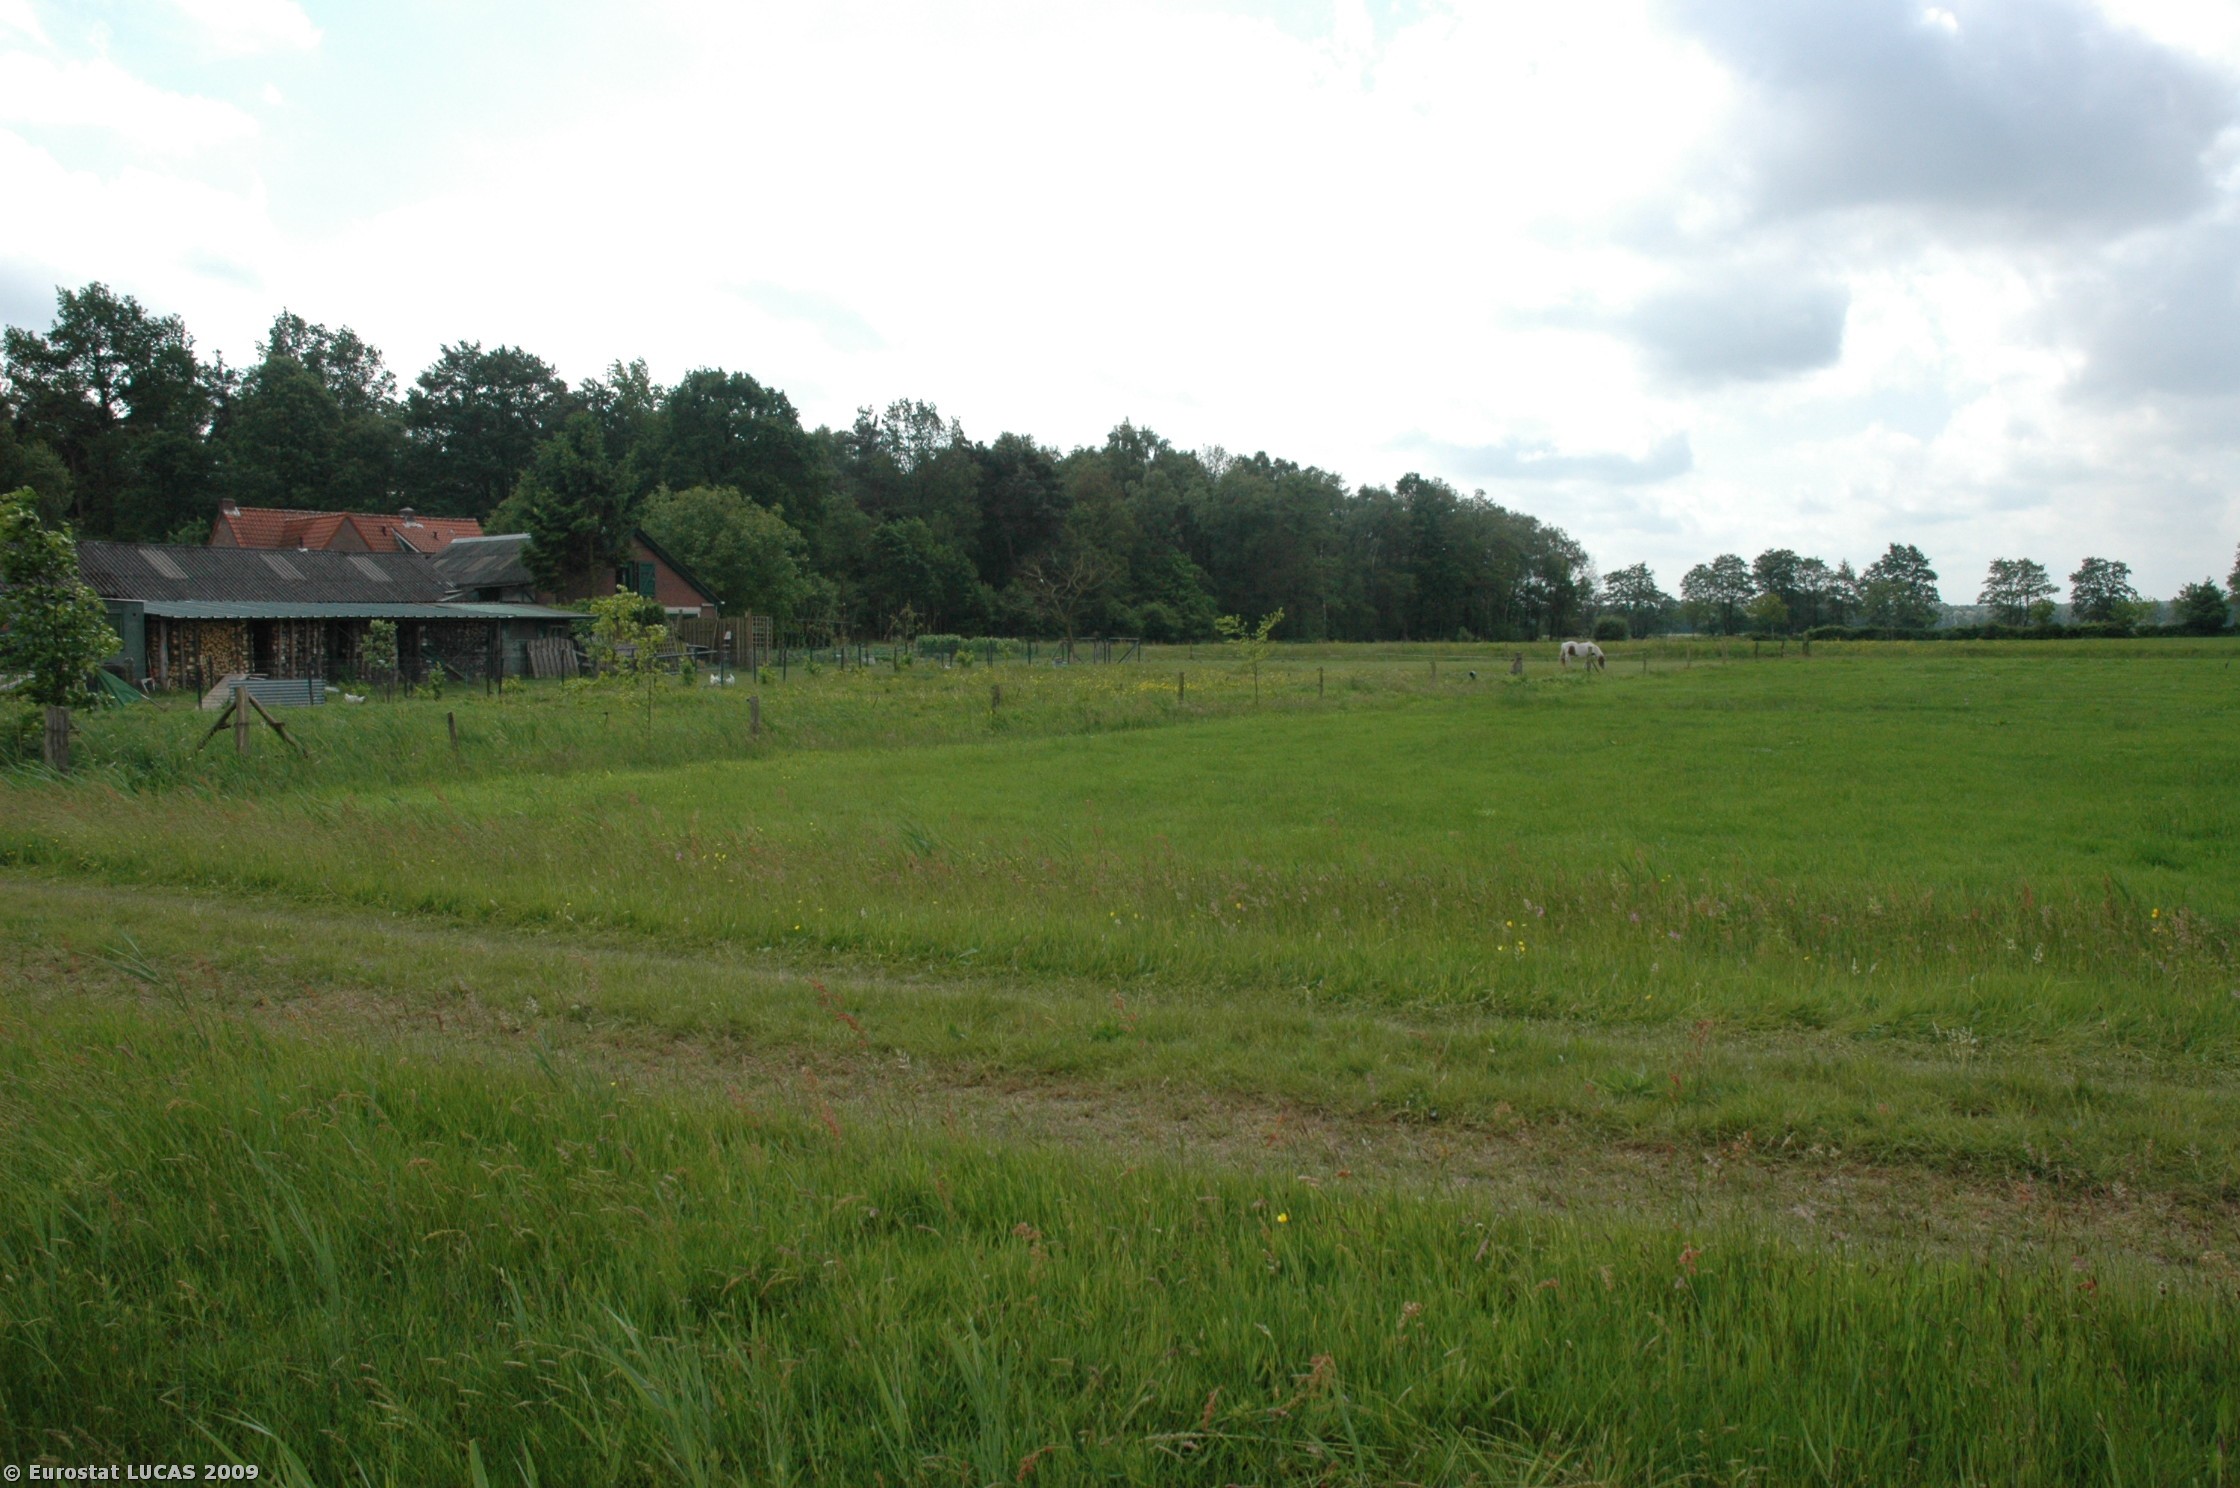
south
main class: Grassland
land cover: Grassland without tree/shrub cover
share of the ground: > 75 %
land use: Agriculture (excluding fallow land and kitchen gardens)
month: May
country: NL
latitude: 52.0796
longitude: 6.1032
